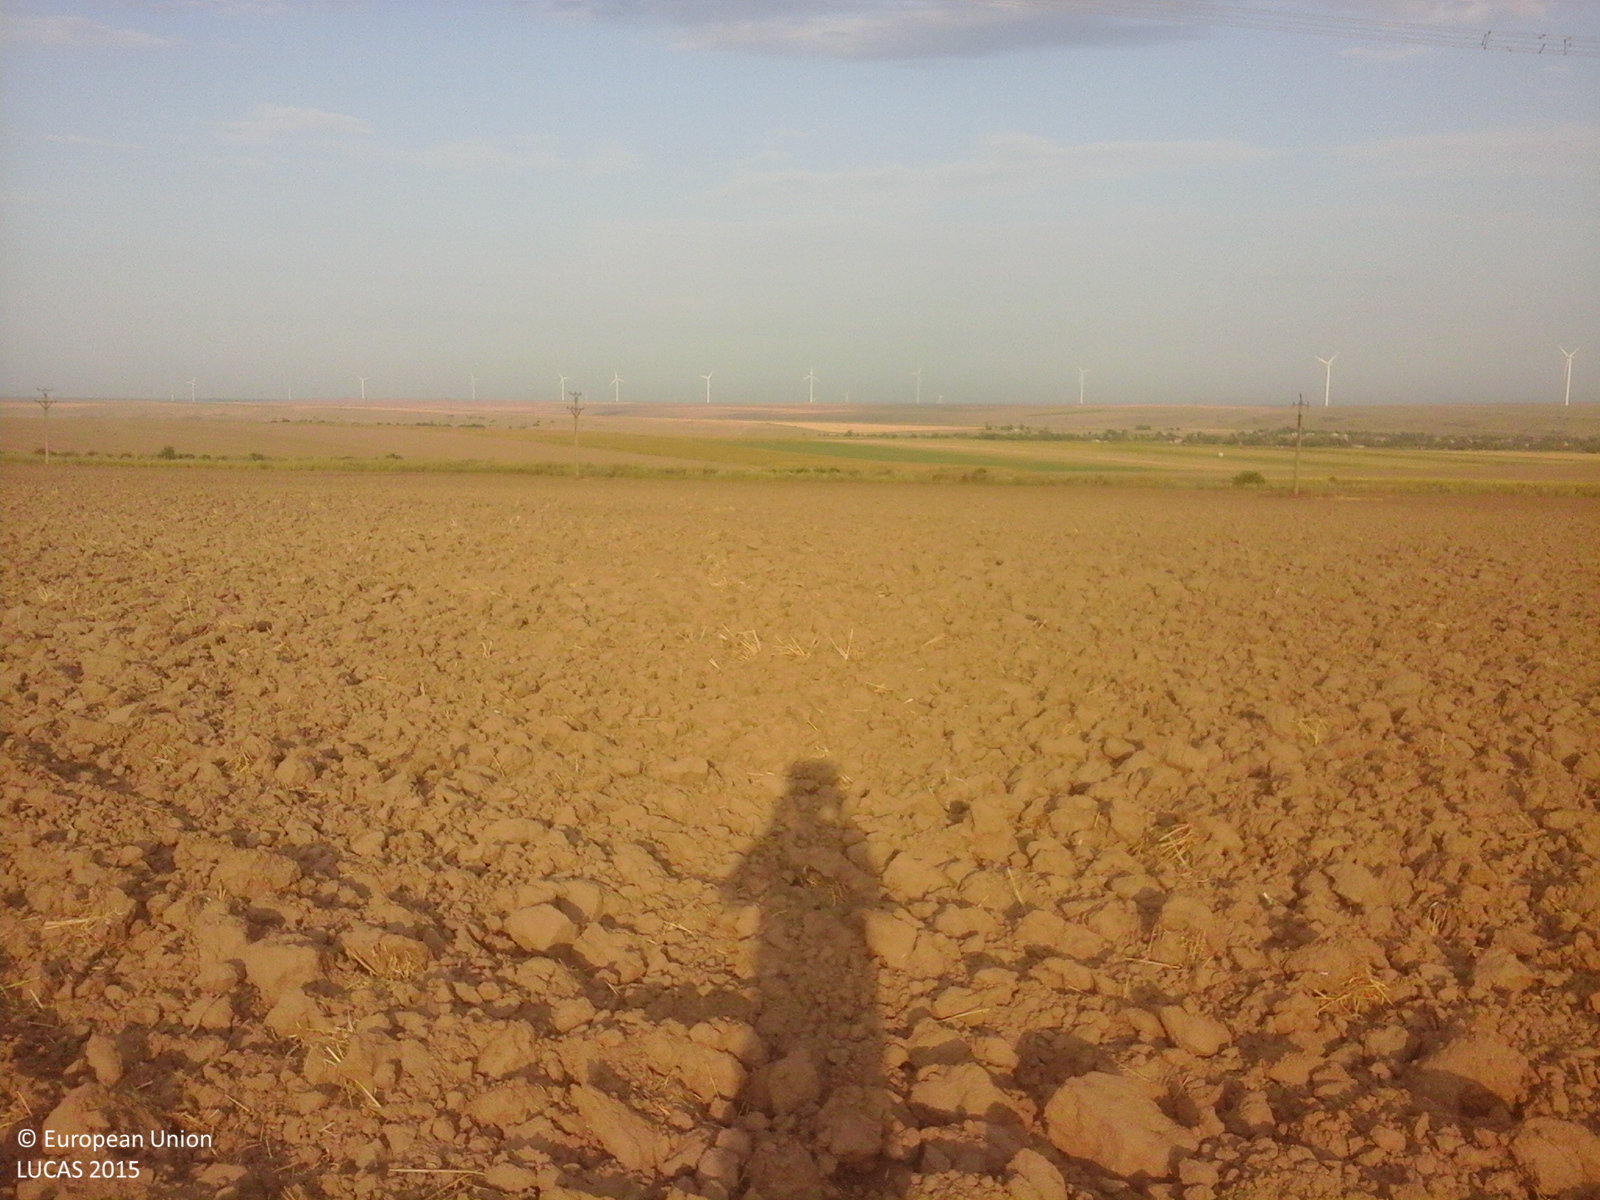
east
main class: Cropland
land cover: Common wheat
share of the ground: < 10 %
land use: Agriculture (excluding fallow land and kitchen gardens)
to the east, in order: Common wheat; Electric lines; Common wheat; Electric lines; Common wheat; Spontaneously vegetated surfaces
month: August
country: RO
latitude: 44.4111
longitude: 28.1572
